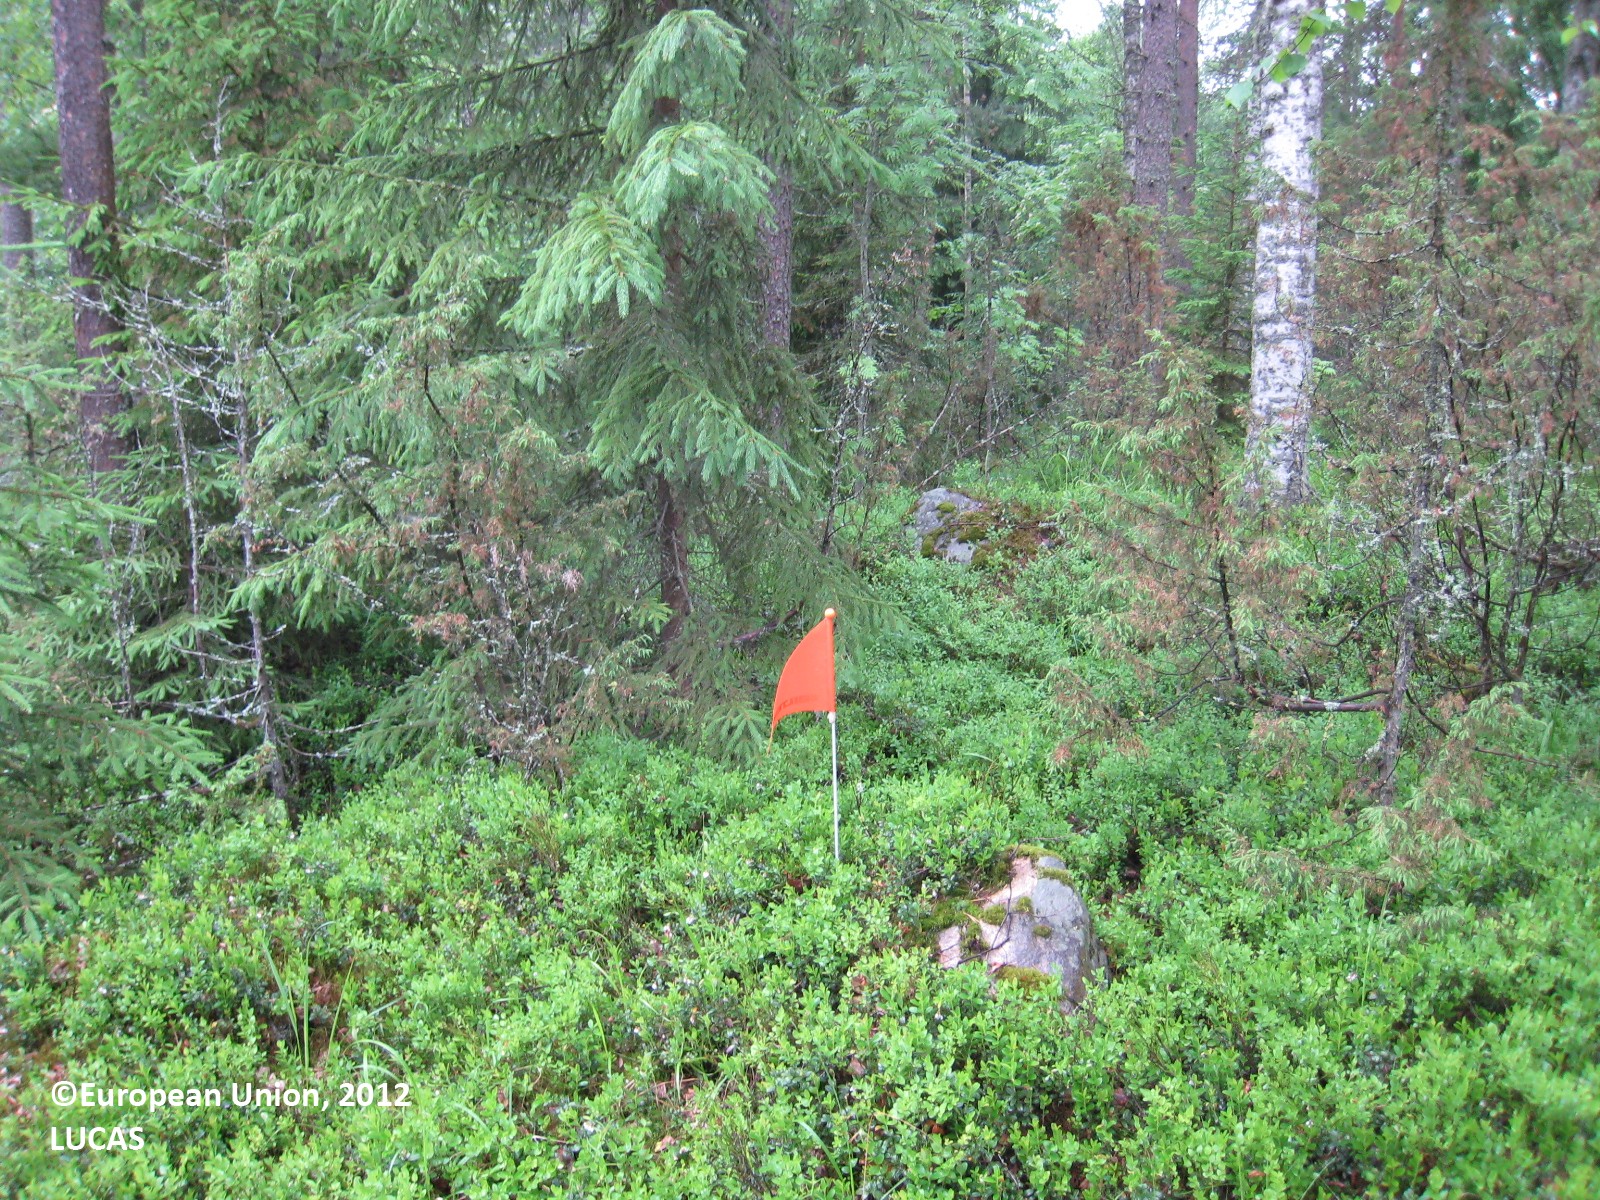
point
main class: Woodland
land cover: Pine dominated mixed woodland
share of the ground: 50 - 75 %
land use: Forestry
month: June
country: FI
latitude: 62.2972
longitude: 25.8763
